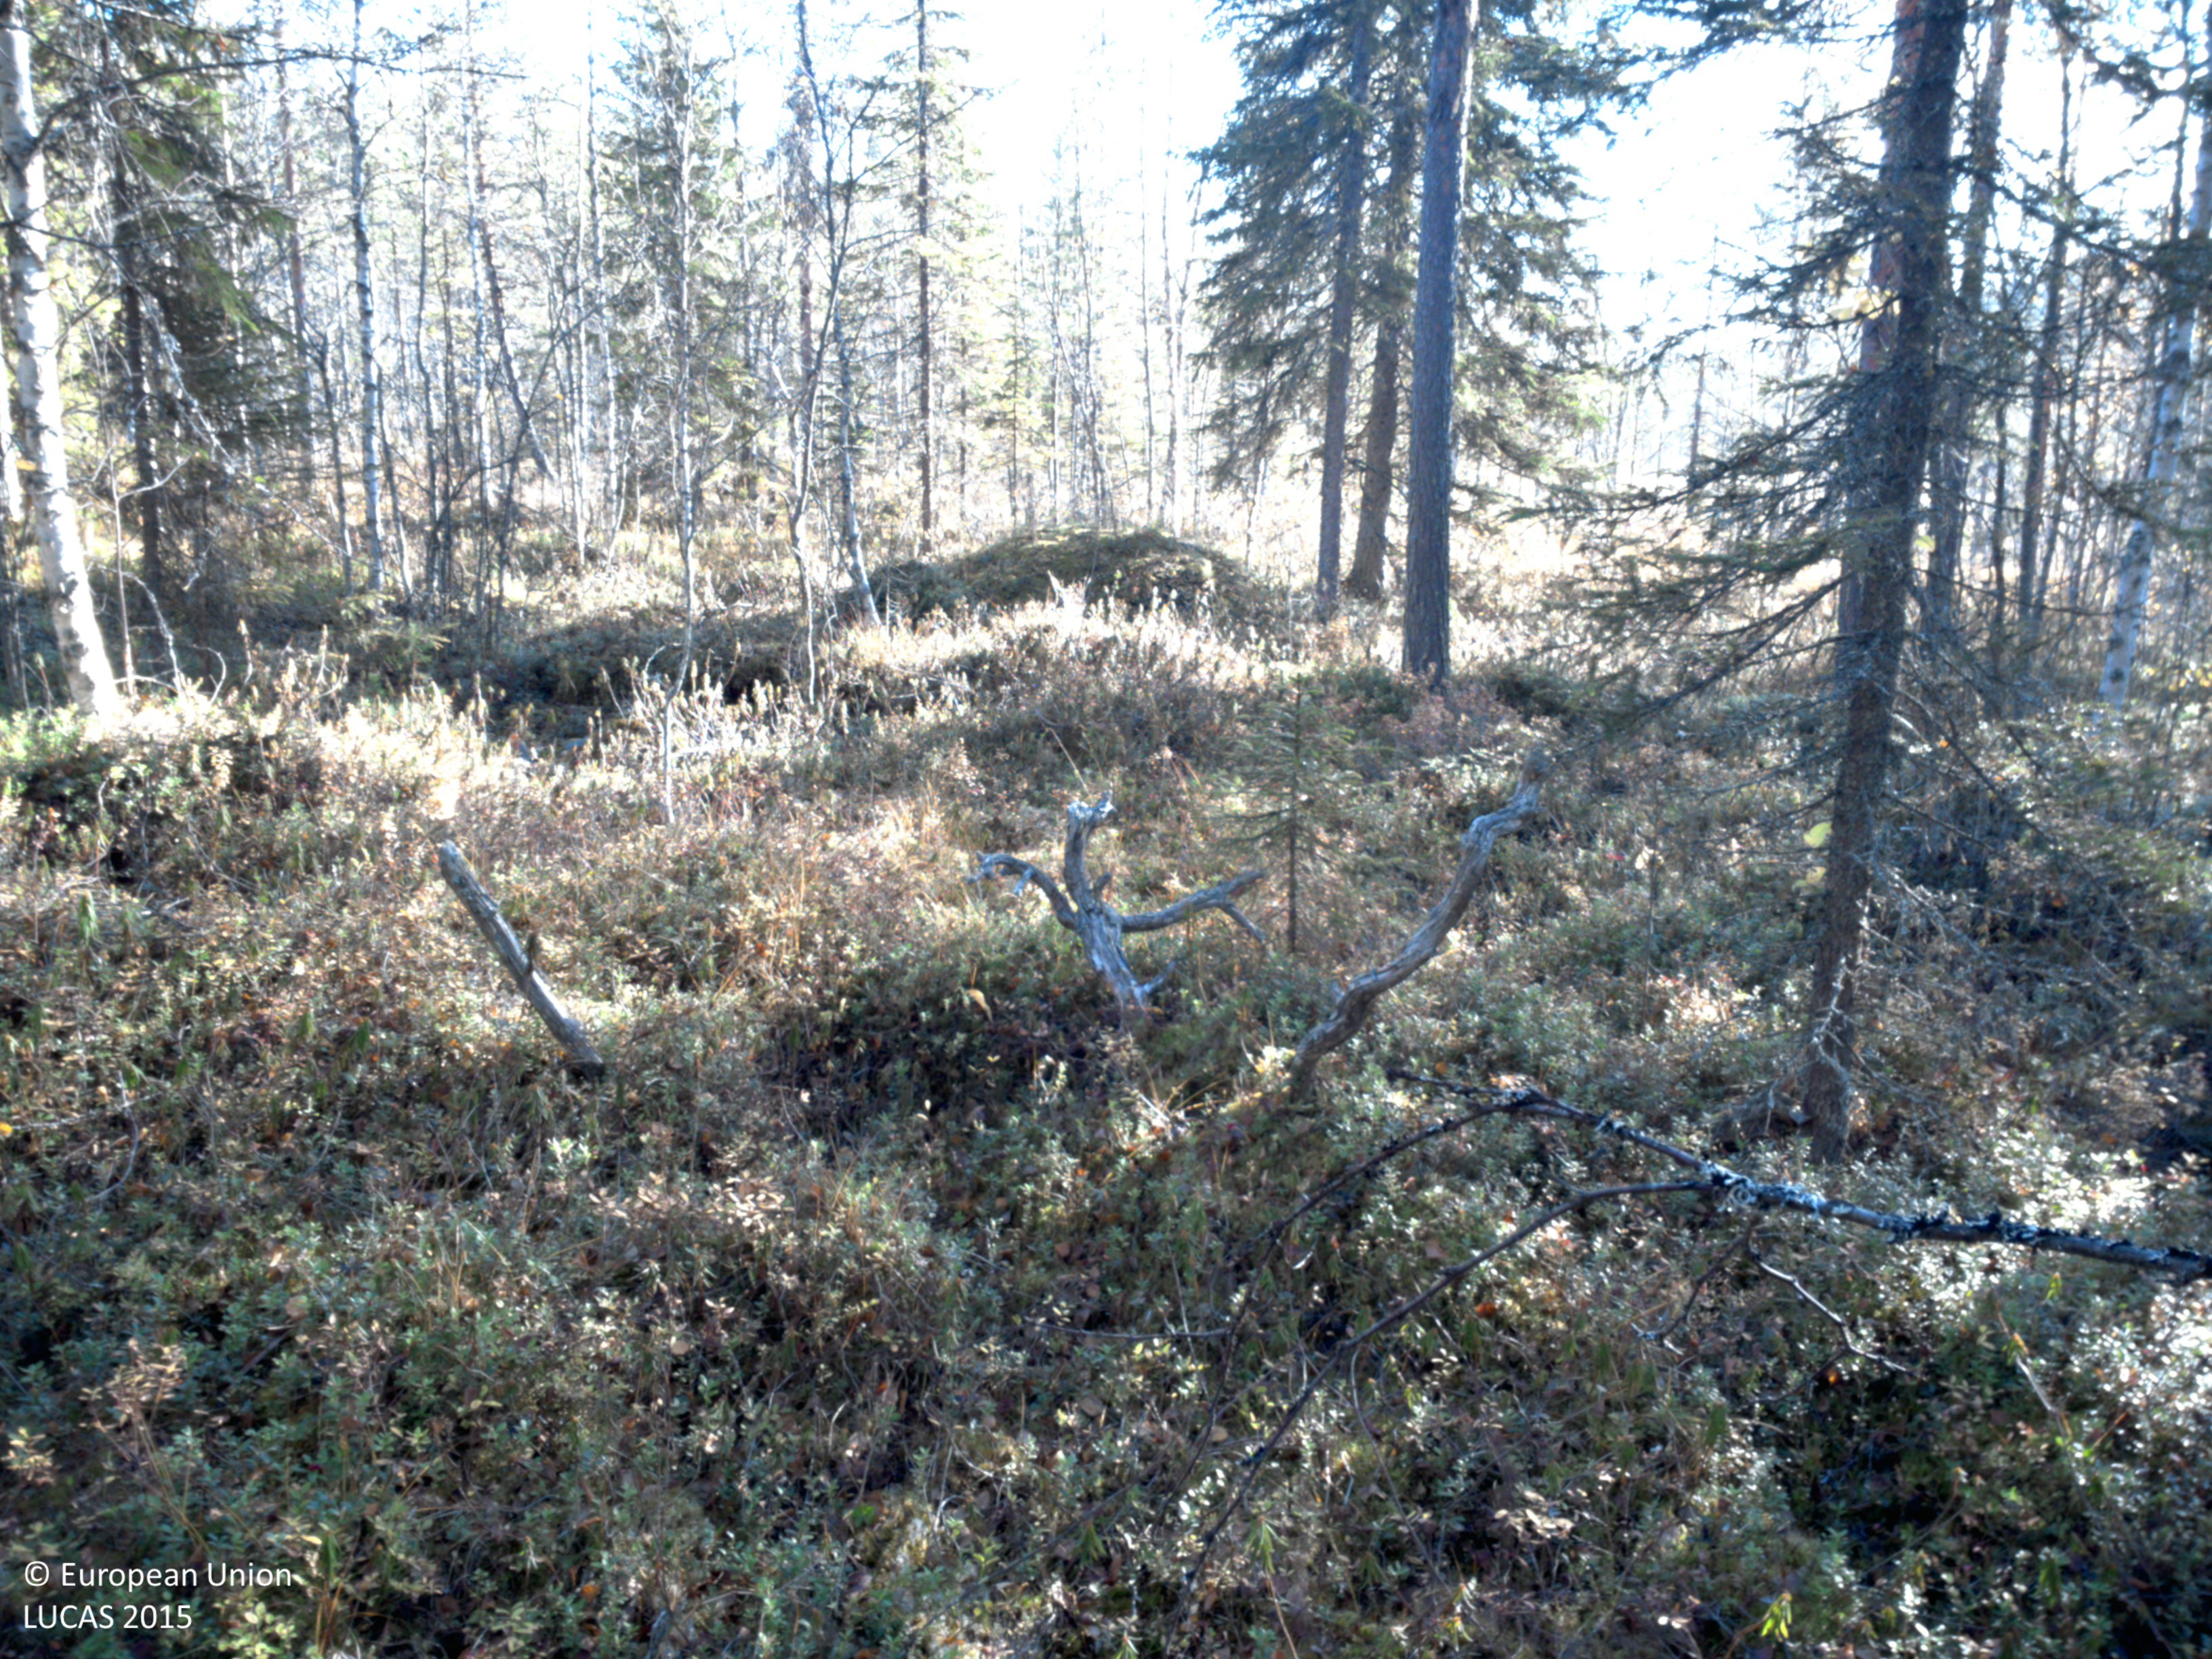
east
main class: Woodland
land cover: Pine dominated mixed woodland
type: boreal forest
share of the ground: 50 - 75 %
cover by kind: coniferous forest trees 45 %, shrubs 35 %, broadleaved forest trees 15 %, lichens and mosses 5 %
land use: Forestry
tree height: > 5 m
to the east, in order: Pine dominated mixed woodland; Pine dominated coniferous woodland
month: September
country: SE
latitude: 64.8606
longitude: 18.5097
